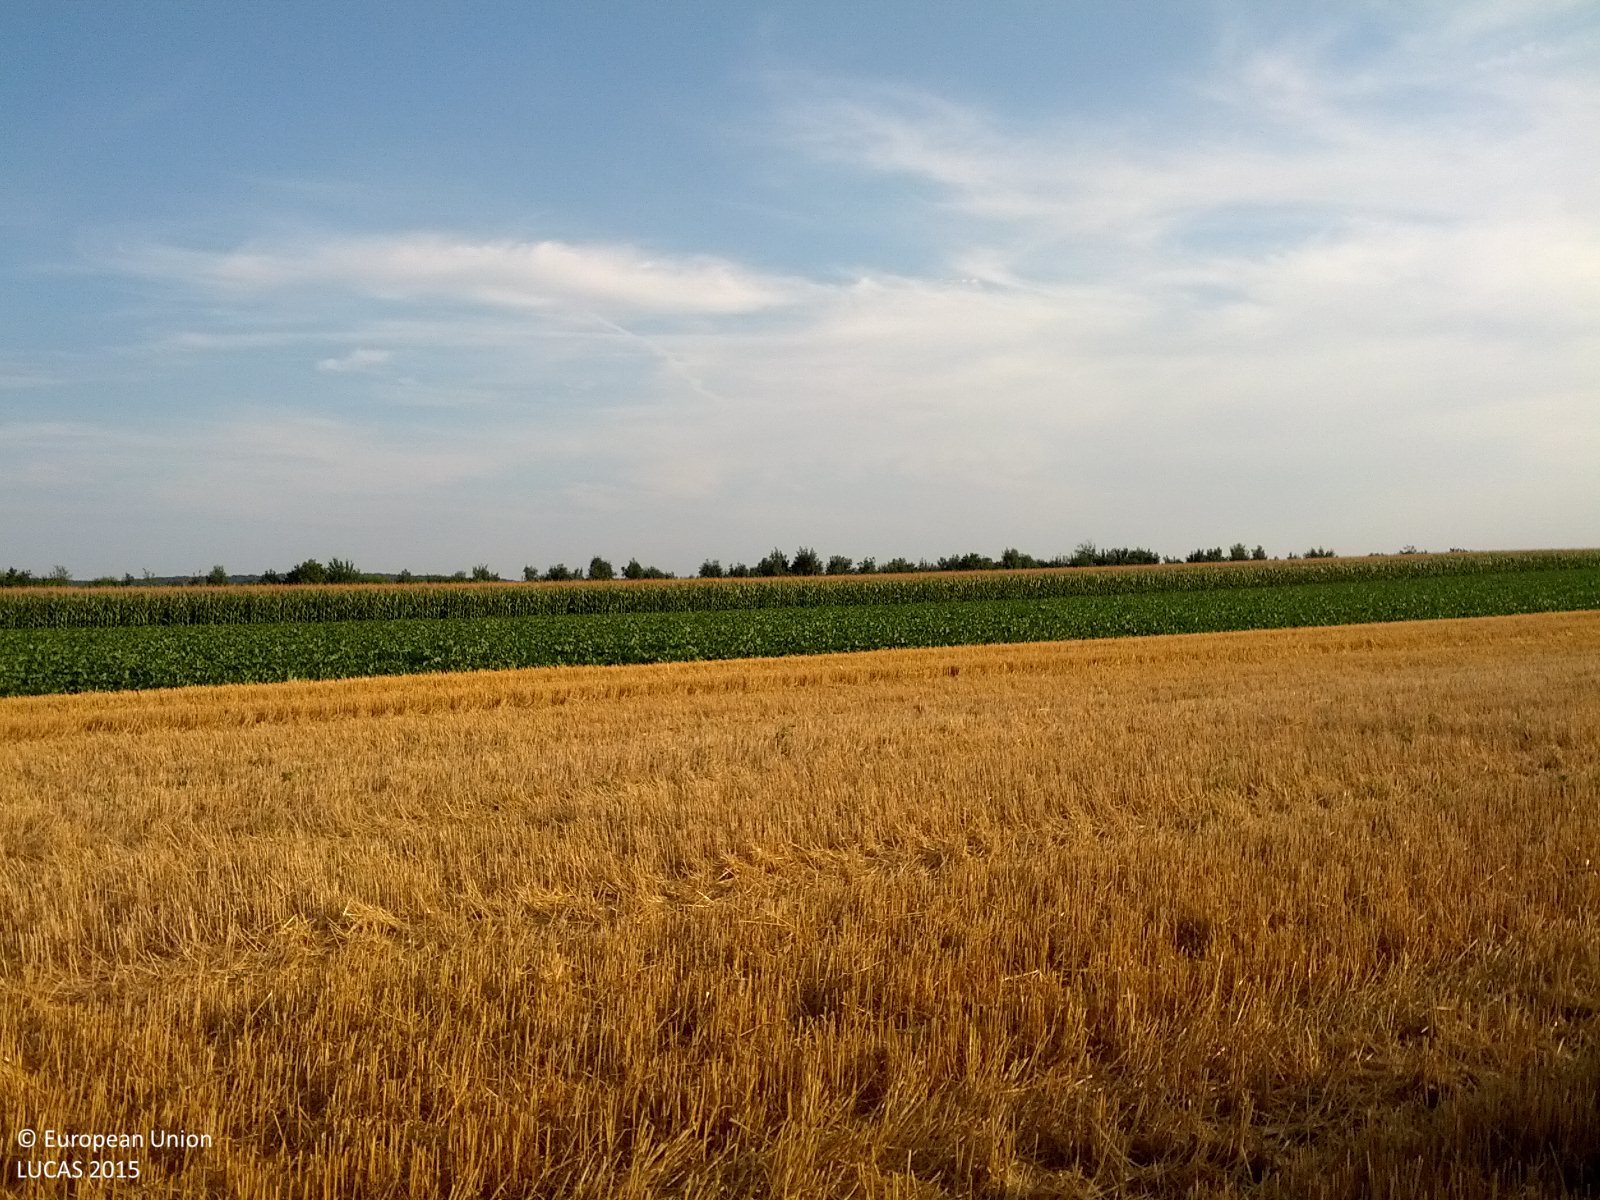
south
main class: Cropland
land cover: Maize
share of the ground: > 75 %
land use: Agriculture (excluding fallow land and kitchen gardens)
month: July
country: AT
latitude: 48.6410
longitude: 16.2618
